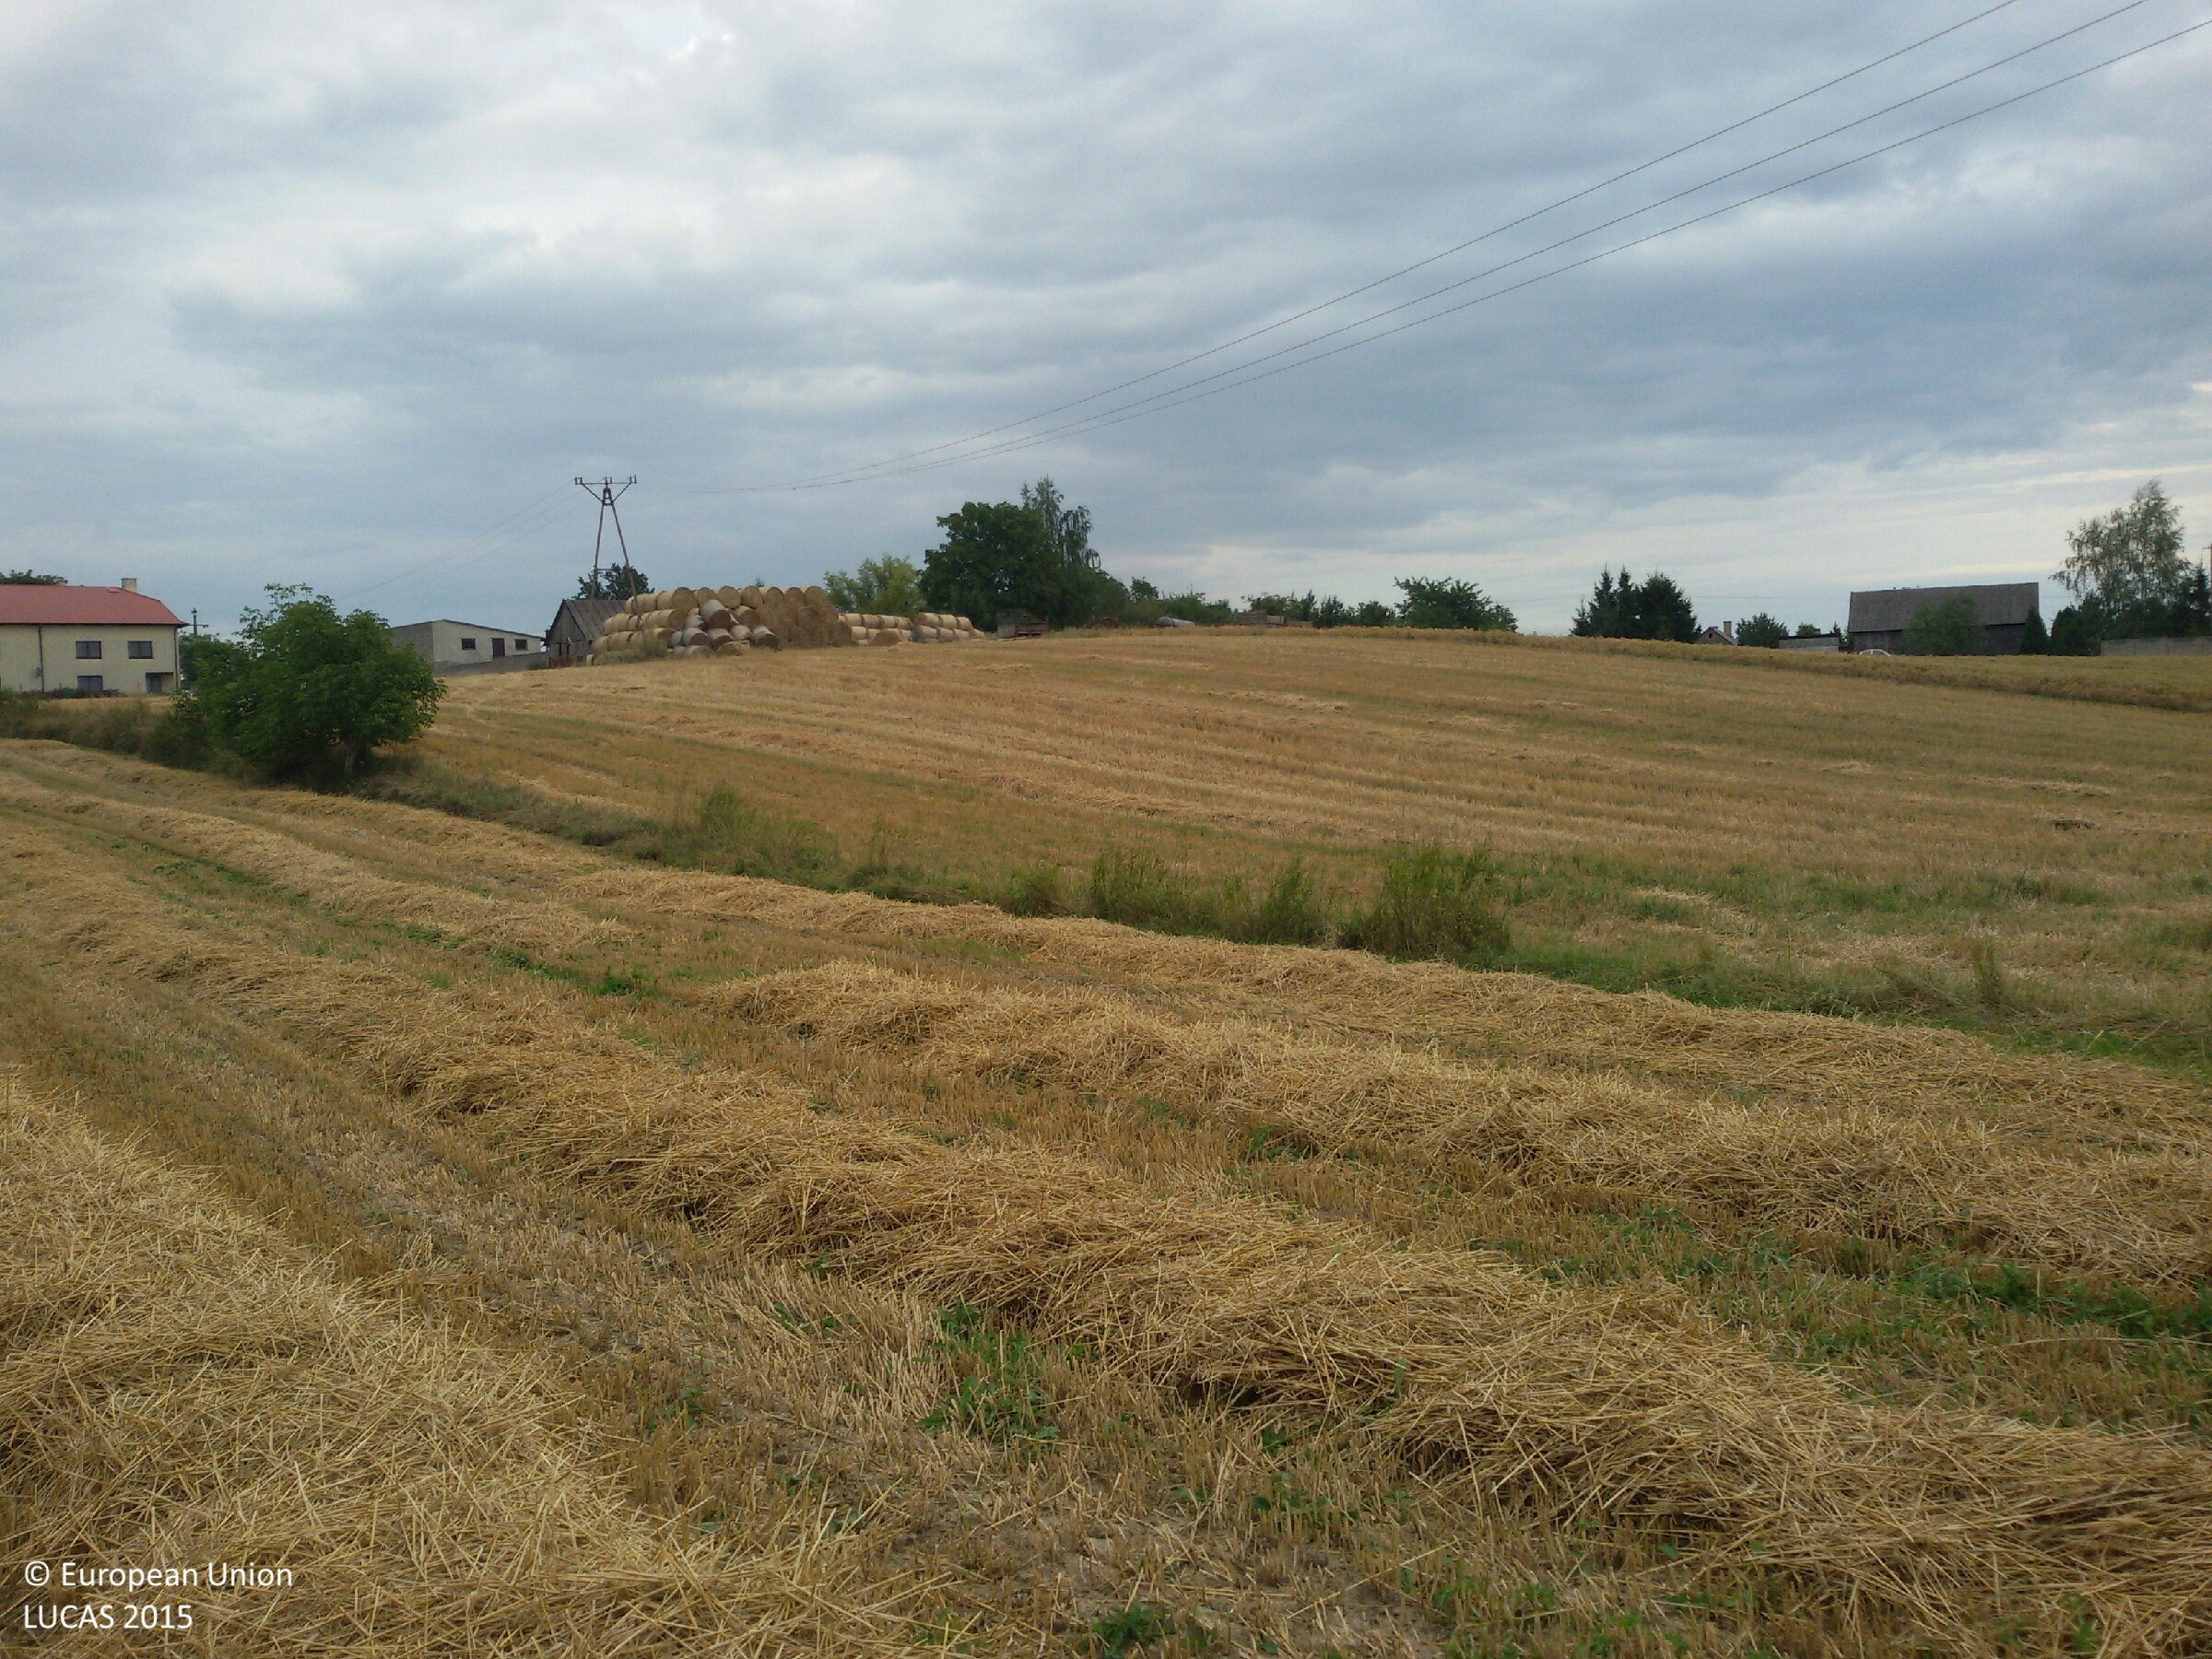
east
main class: Cropland
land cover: Triticale
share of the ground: > 75 %
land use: Agriculture (excluding fallow land and kitchen gardens)
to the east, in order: Triticale; Grass margins; Common wheat; Electric lines; Common wheat; Grassland without tree/shrub cover; Artificial constructions in urban areas; Common wheat; Grass margins; Common wheat; Triticale; Common wheat; Other fruit trees and berries
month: August
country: PL
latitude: 50.7897
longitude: 21.4123
